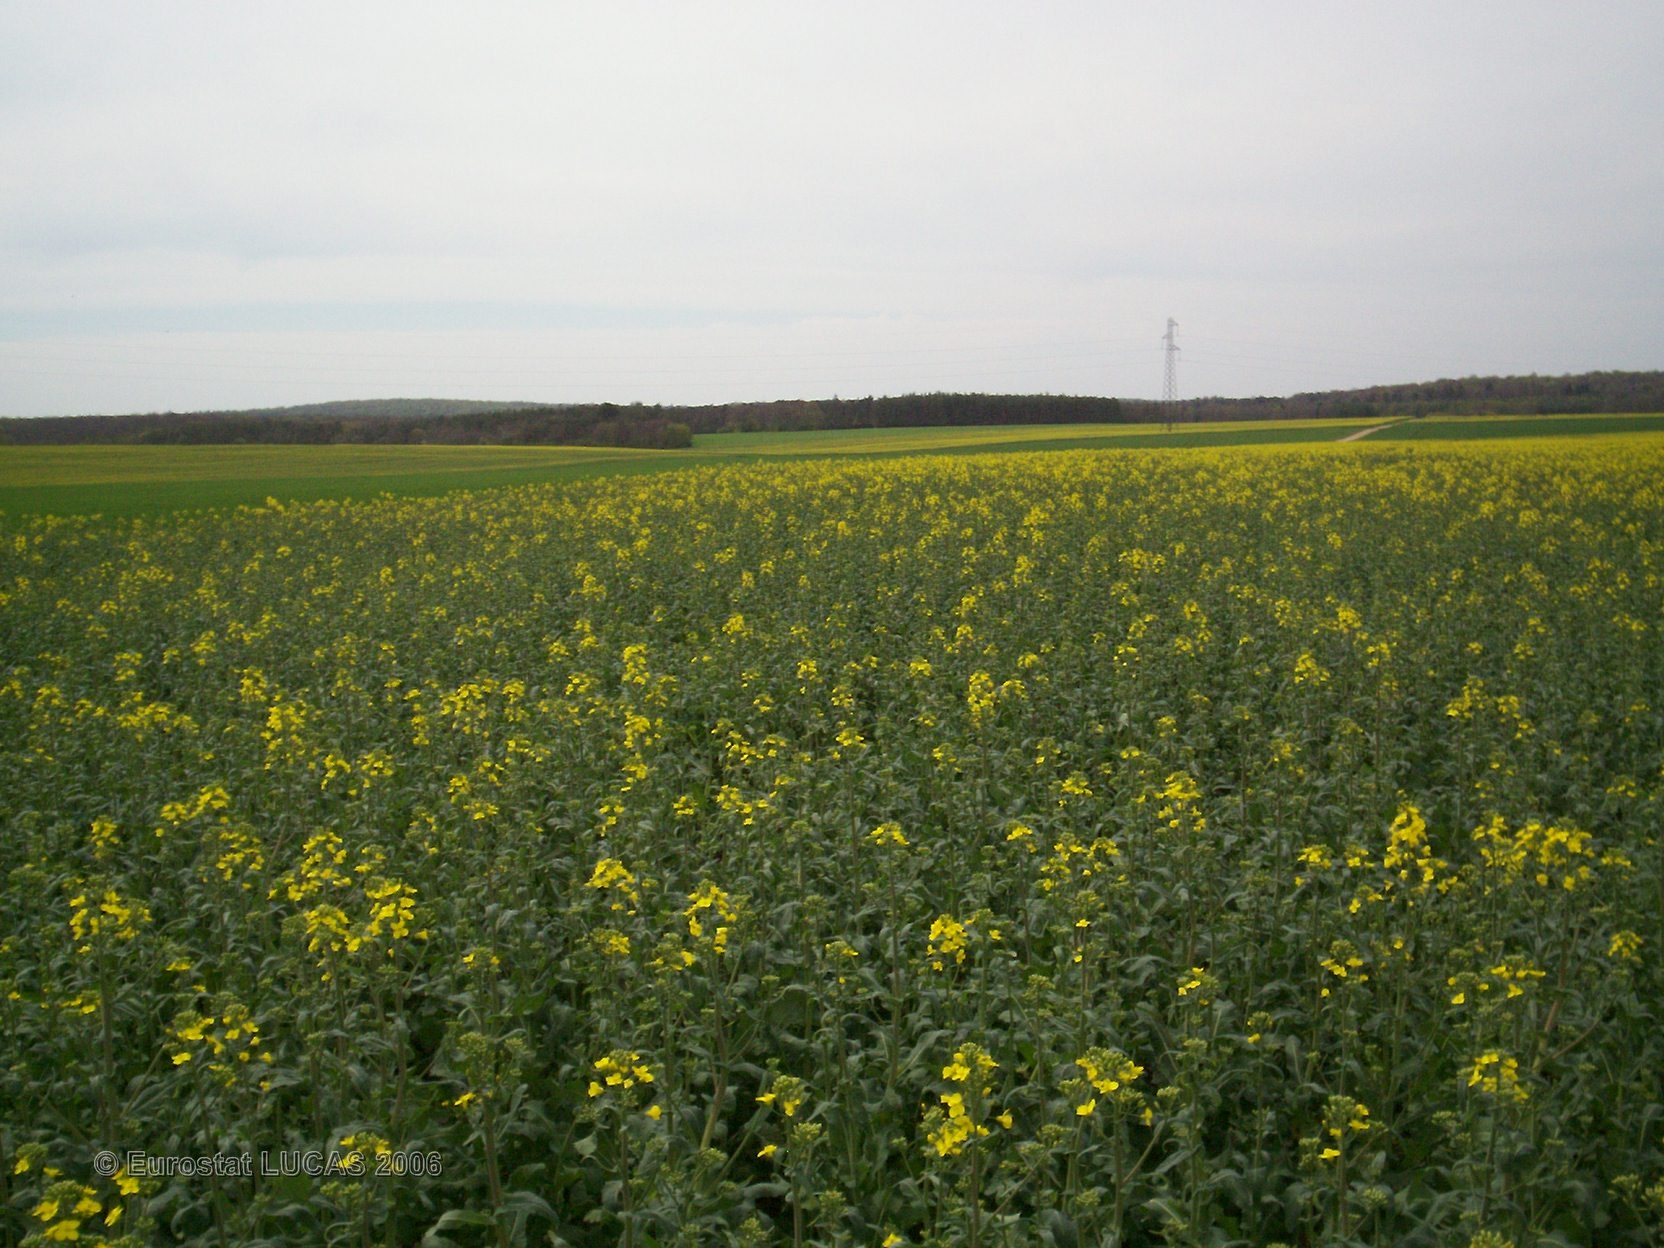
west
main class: Cropland
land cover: Rape and turnip rape
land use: Agriculture (excluding fallow land and kitchen gardens)
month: May
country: FR
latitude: 47.6547
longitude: 4.5267
